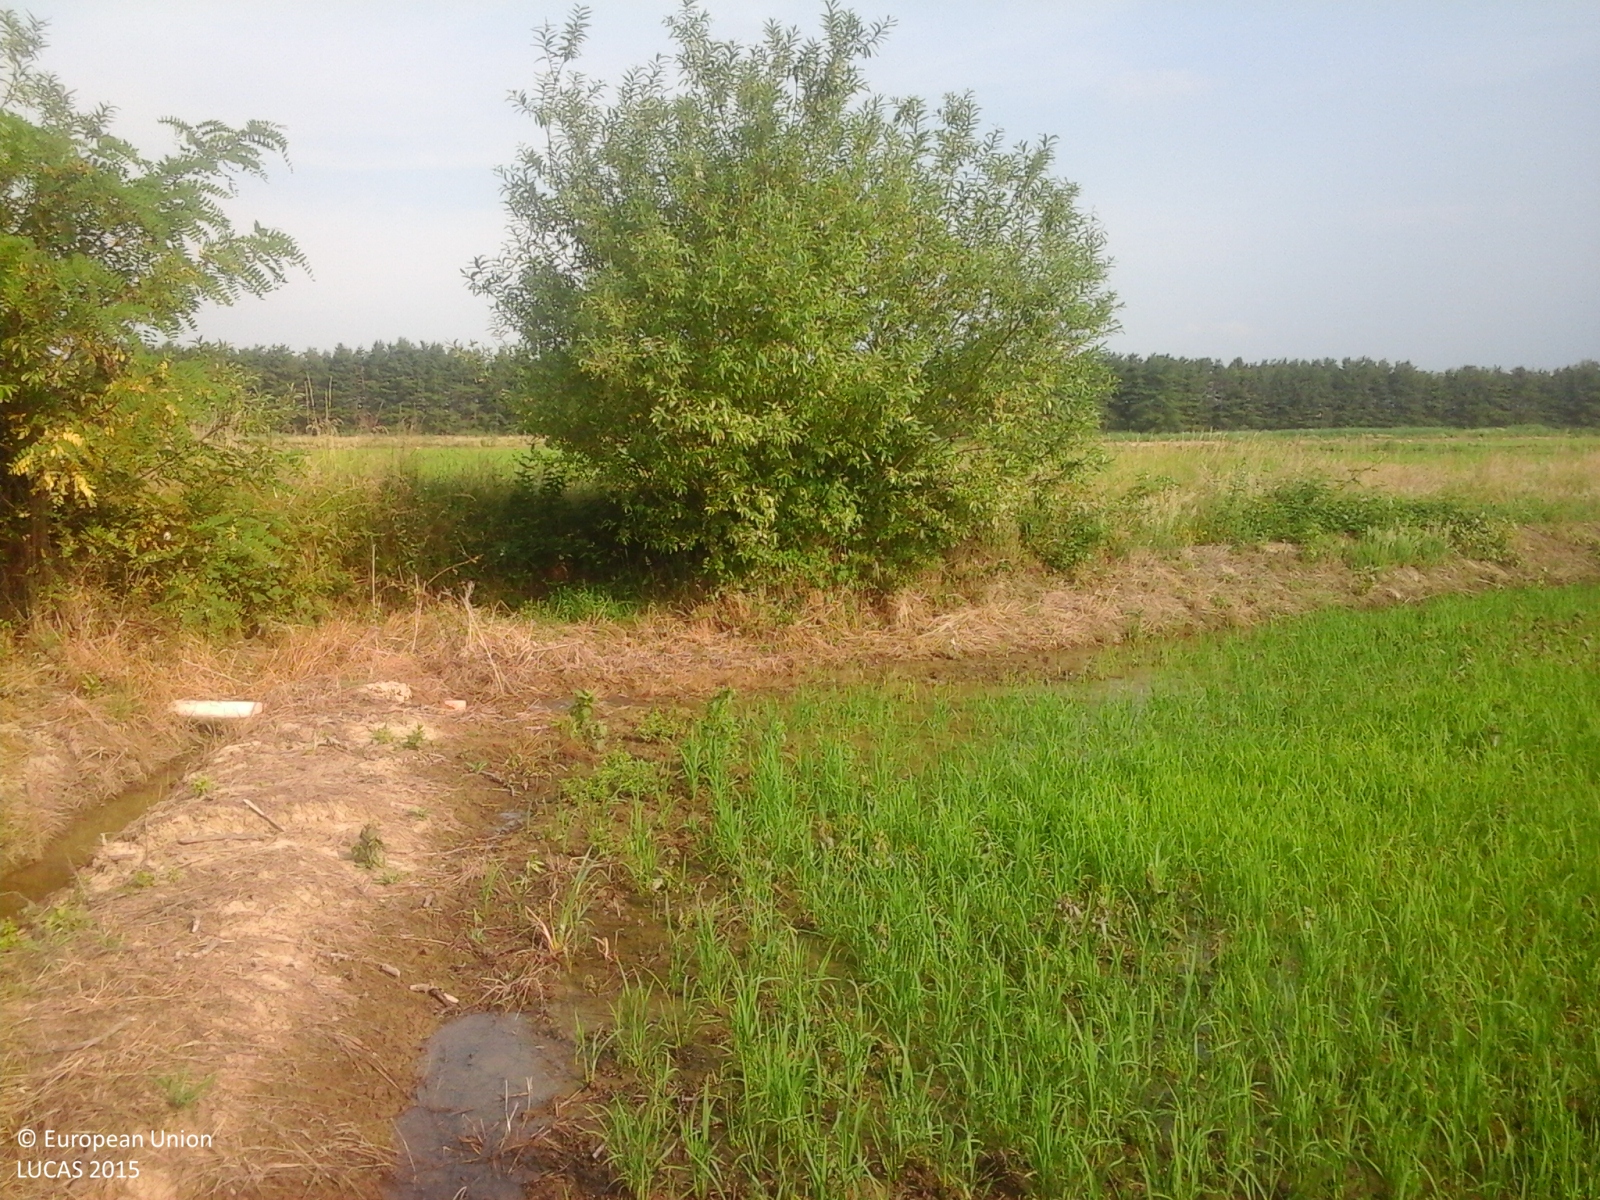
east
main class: Cropland
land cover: Rice
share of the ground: 50 - 75 %
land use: Agriculture (excluding fallow land and kitchen gardens)
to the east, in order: Rice; Grass margins; Ditches and canals; Grass margins; Tracks; Rice; Other structural elements; Rice; Electric lines; Grass margins; Ditches and canals; Grass margins; Rice
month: June
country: IT
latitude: 45.4907
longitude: 8.3010
